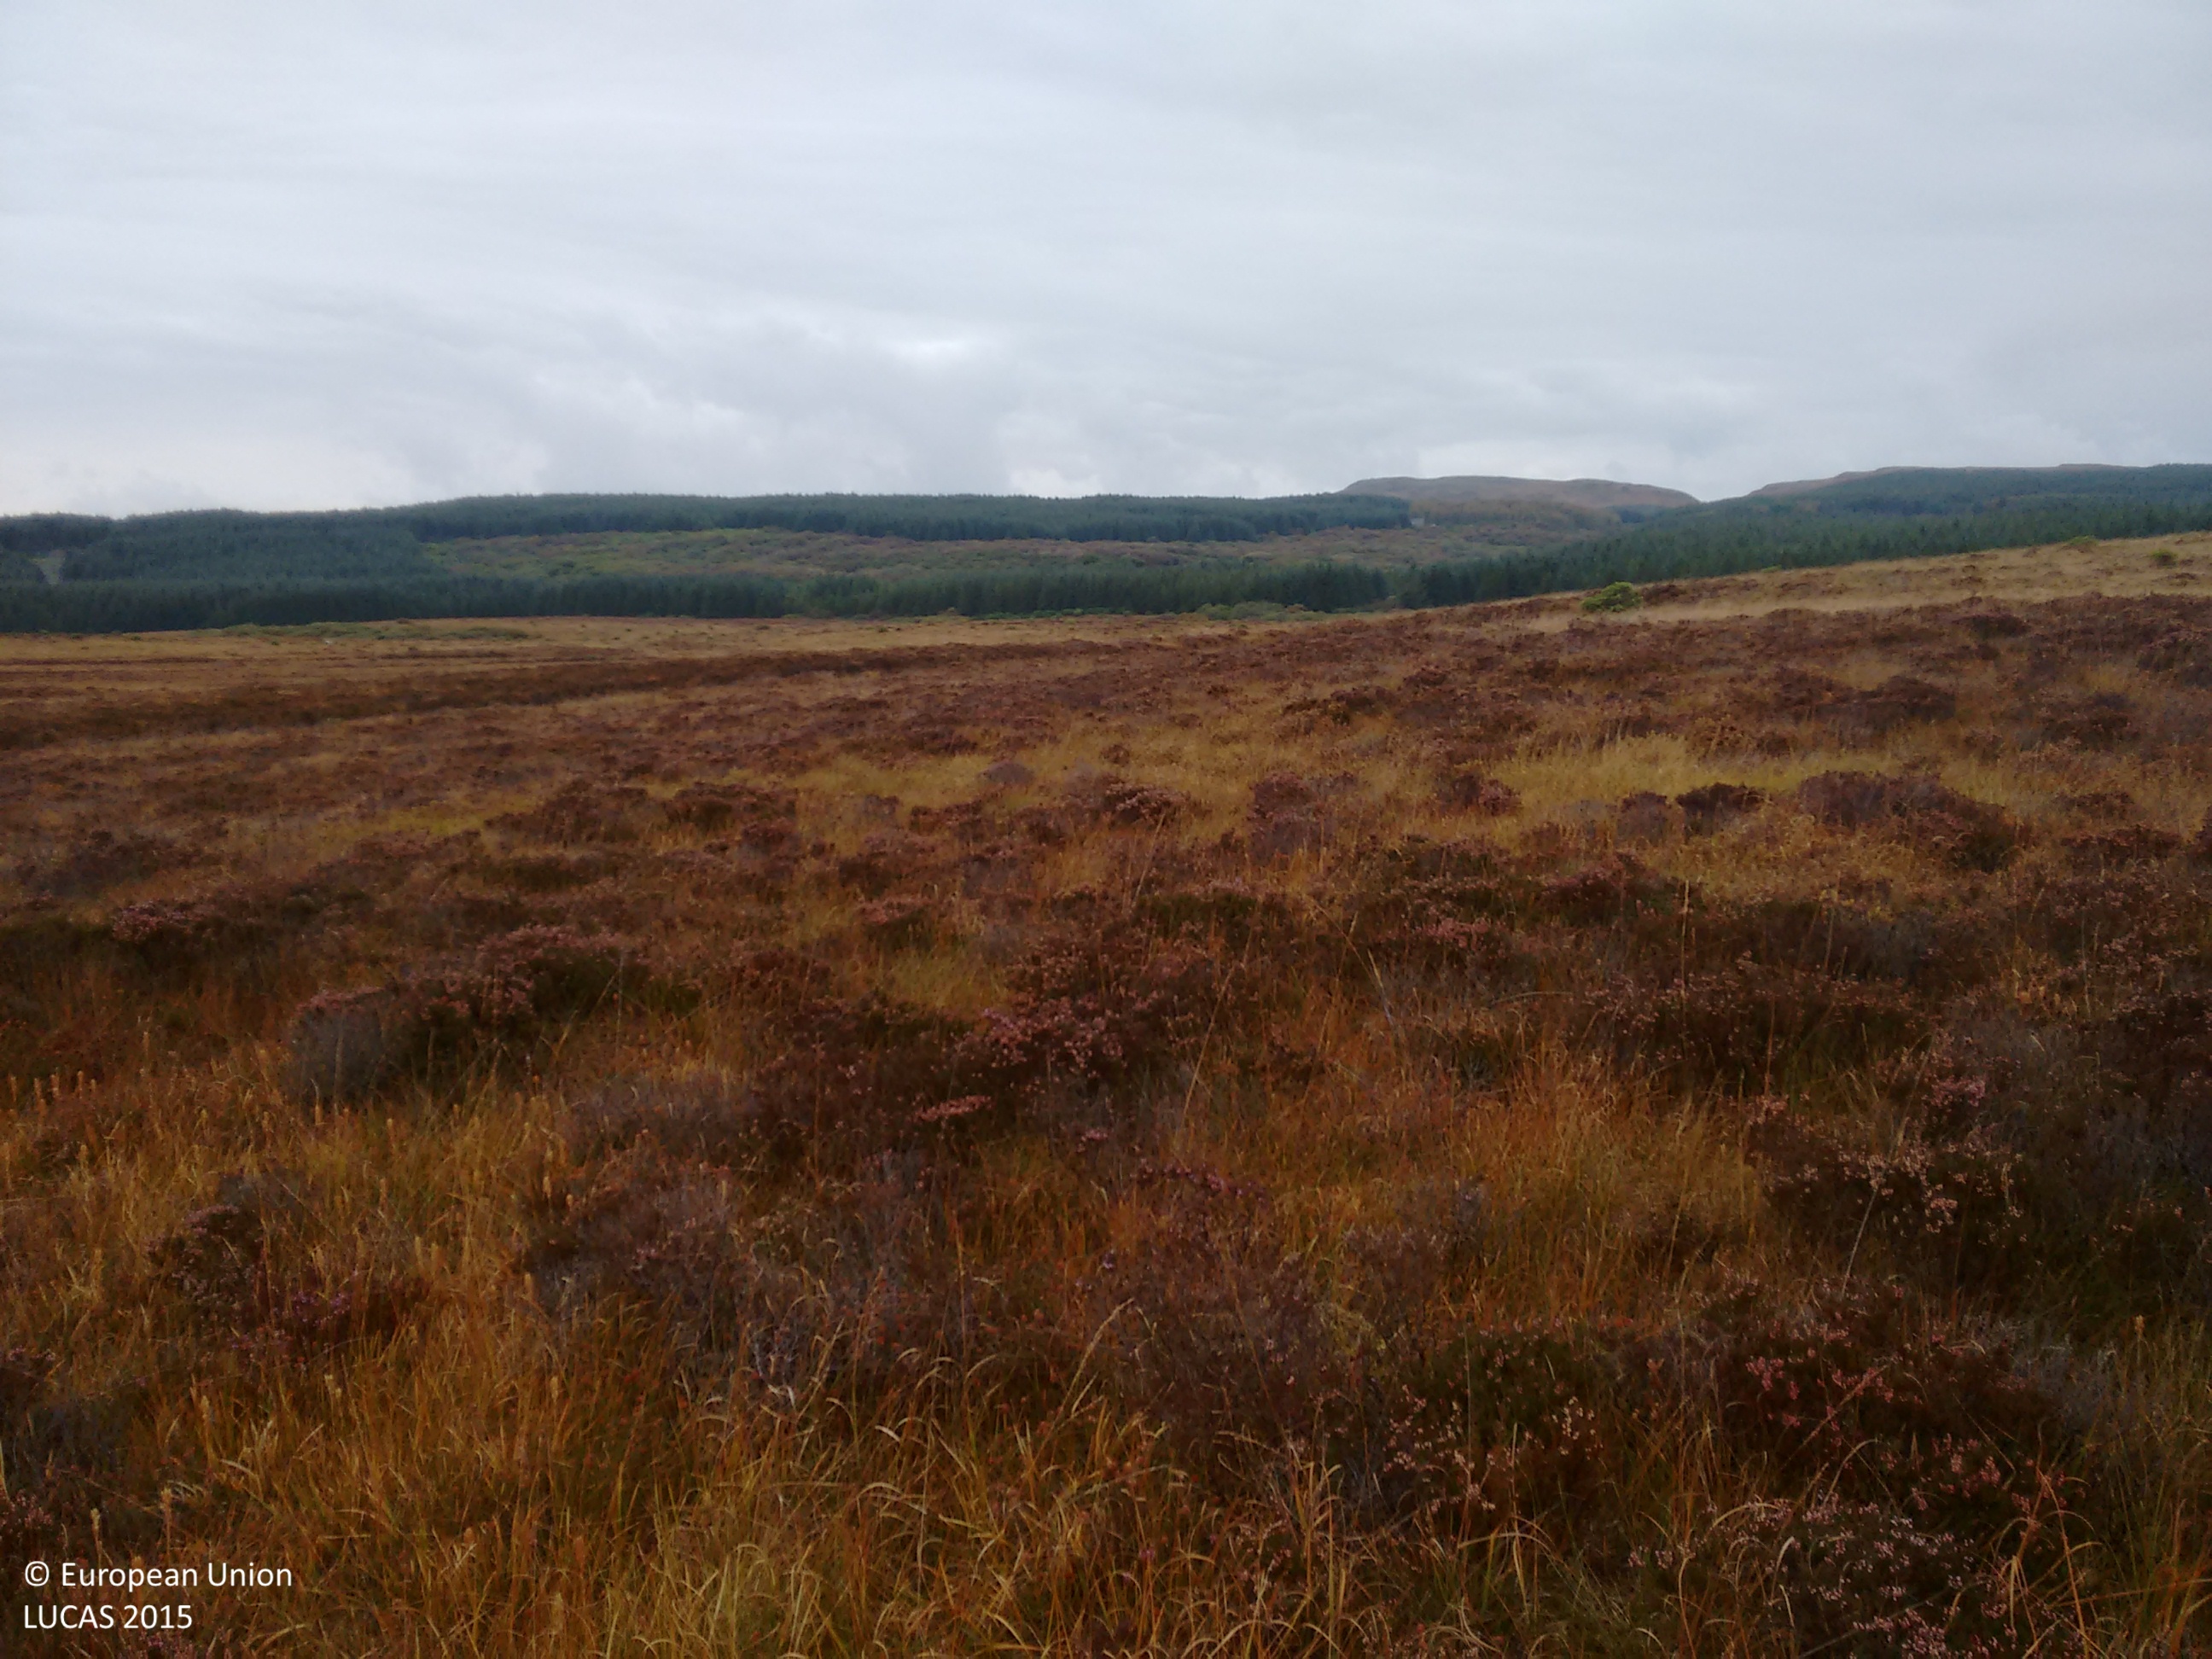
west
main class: Shrubland
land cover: Shrubland without tree cover
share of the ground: > 75 %
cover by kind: shrubs 80 %, herbaceous plants 10 %, lichens and mosses 10 %
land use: Agriculture (excluding fallow land and kitchen gardens)
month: October
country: GB
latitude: 55.8729
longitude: -6.1385
